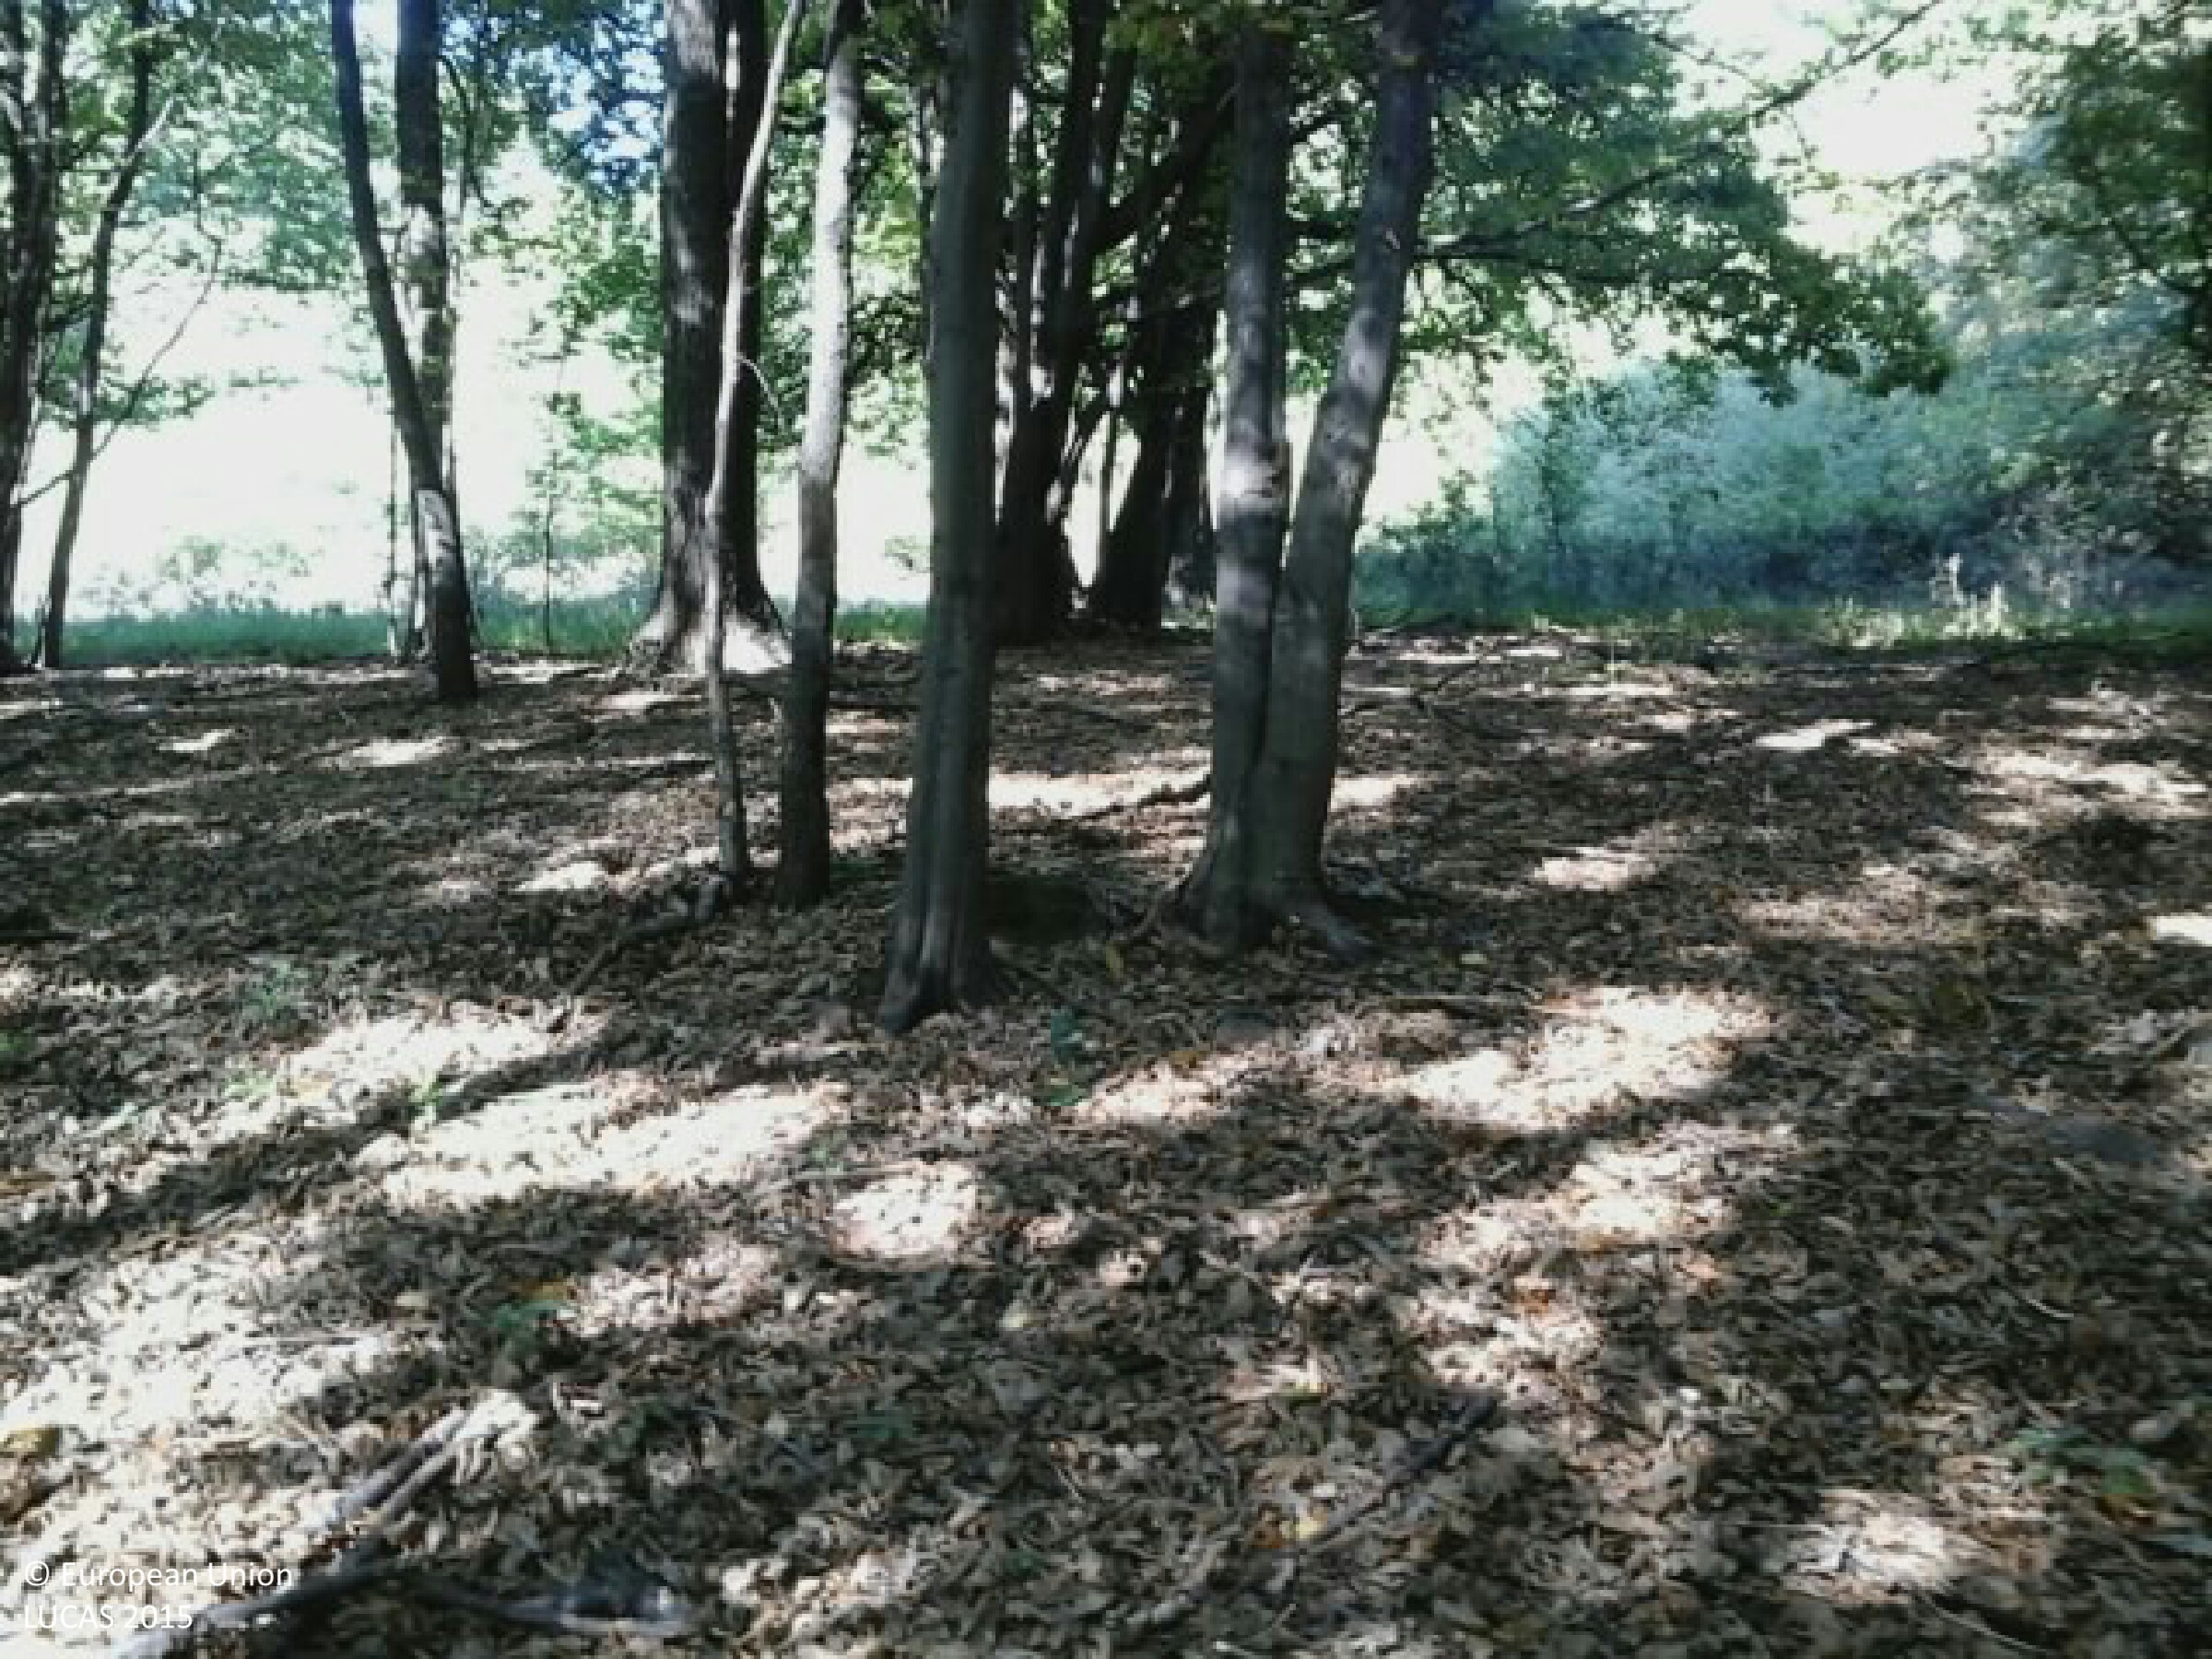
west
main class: Woodland
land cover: Broadleaved woodland
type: beech forest
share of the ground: > 75 %
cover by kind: broadleaved forest trees 100 %
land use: Forestry
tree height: > 5 m
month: September
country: HU
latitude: 47.8896
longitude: 19.8562
